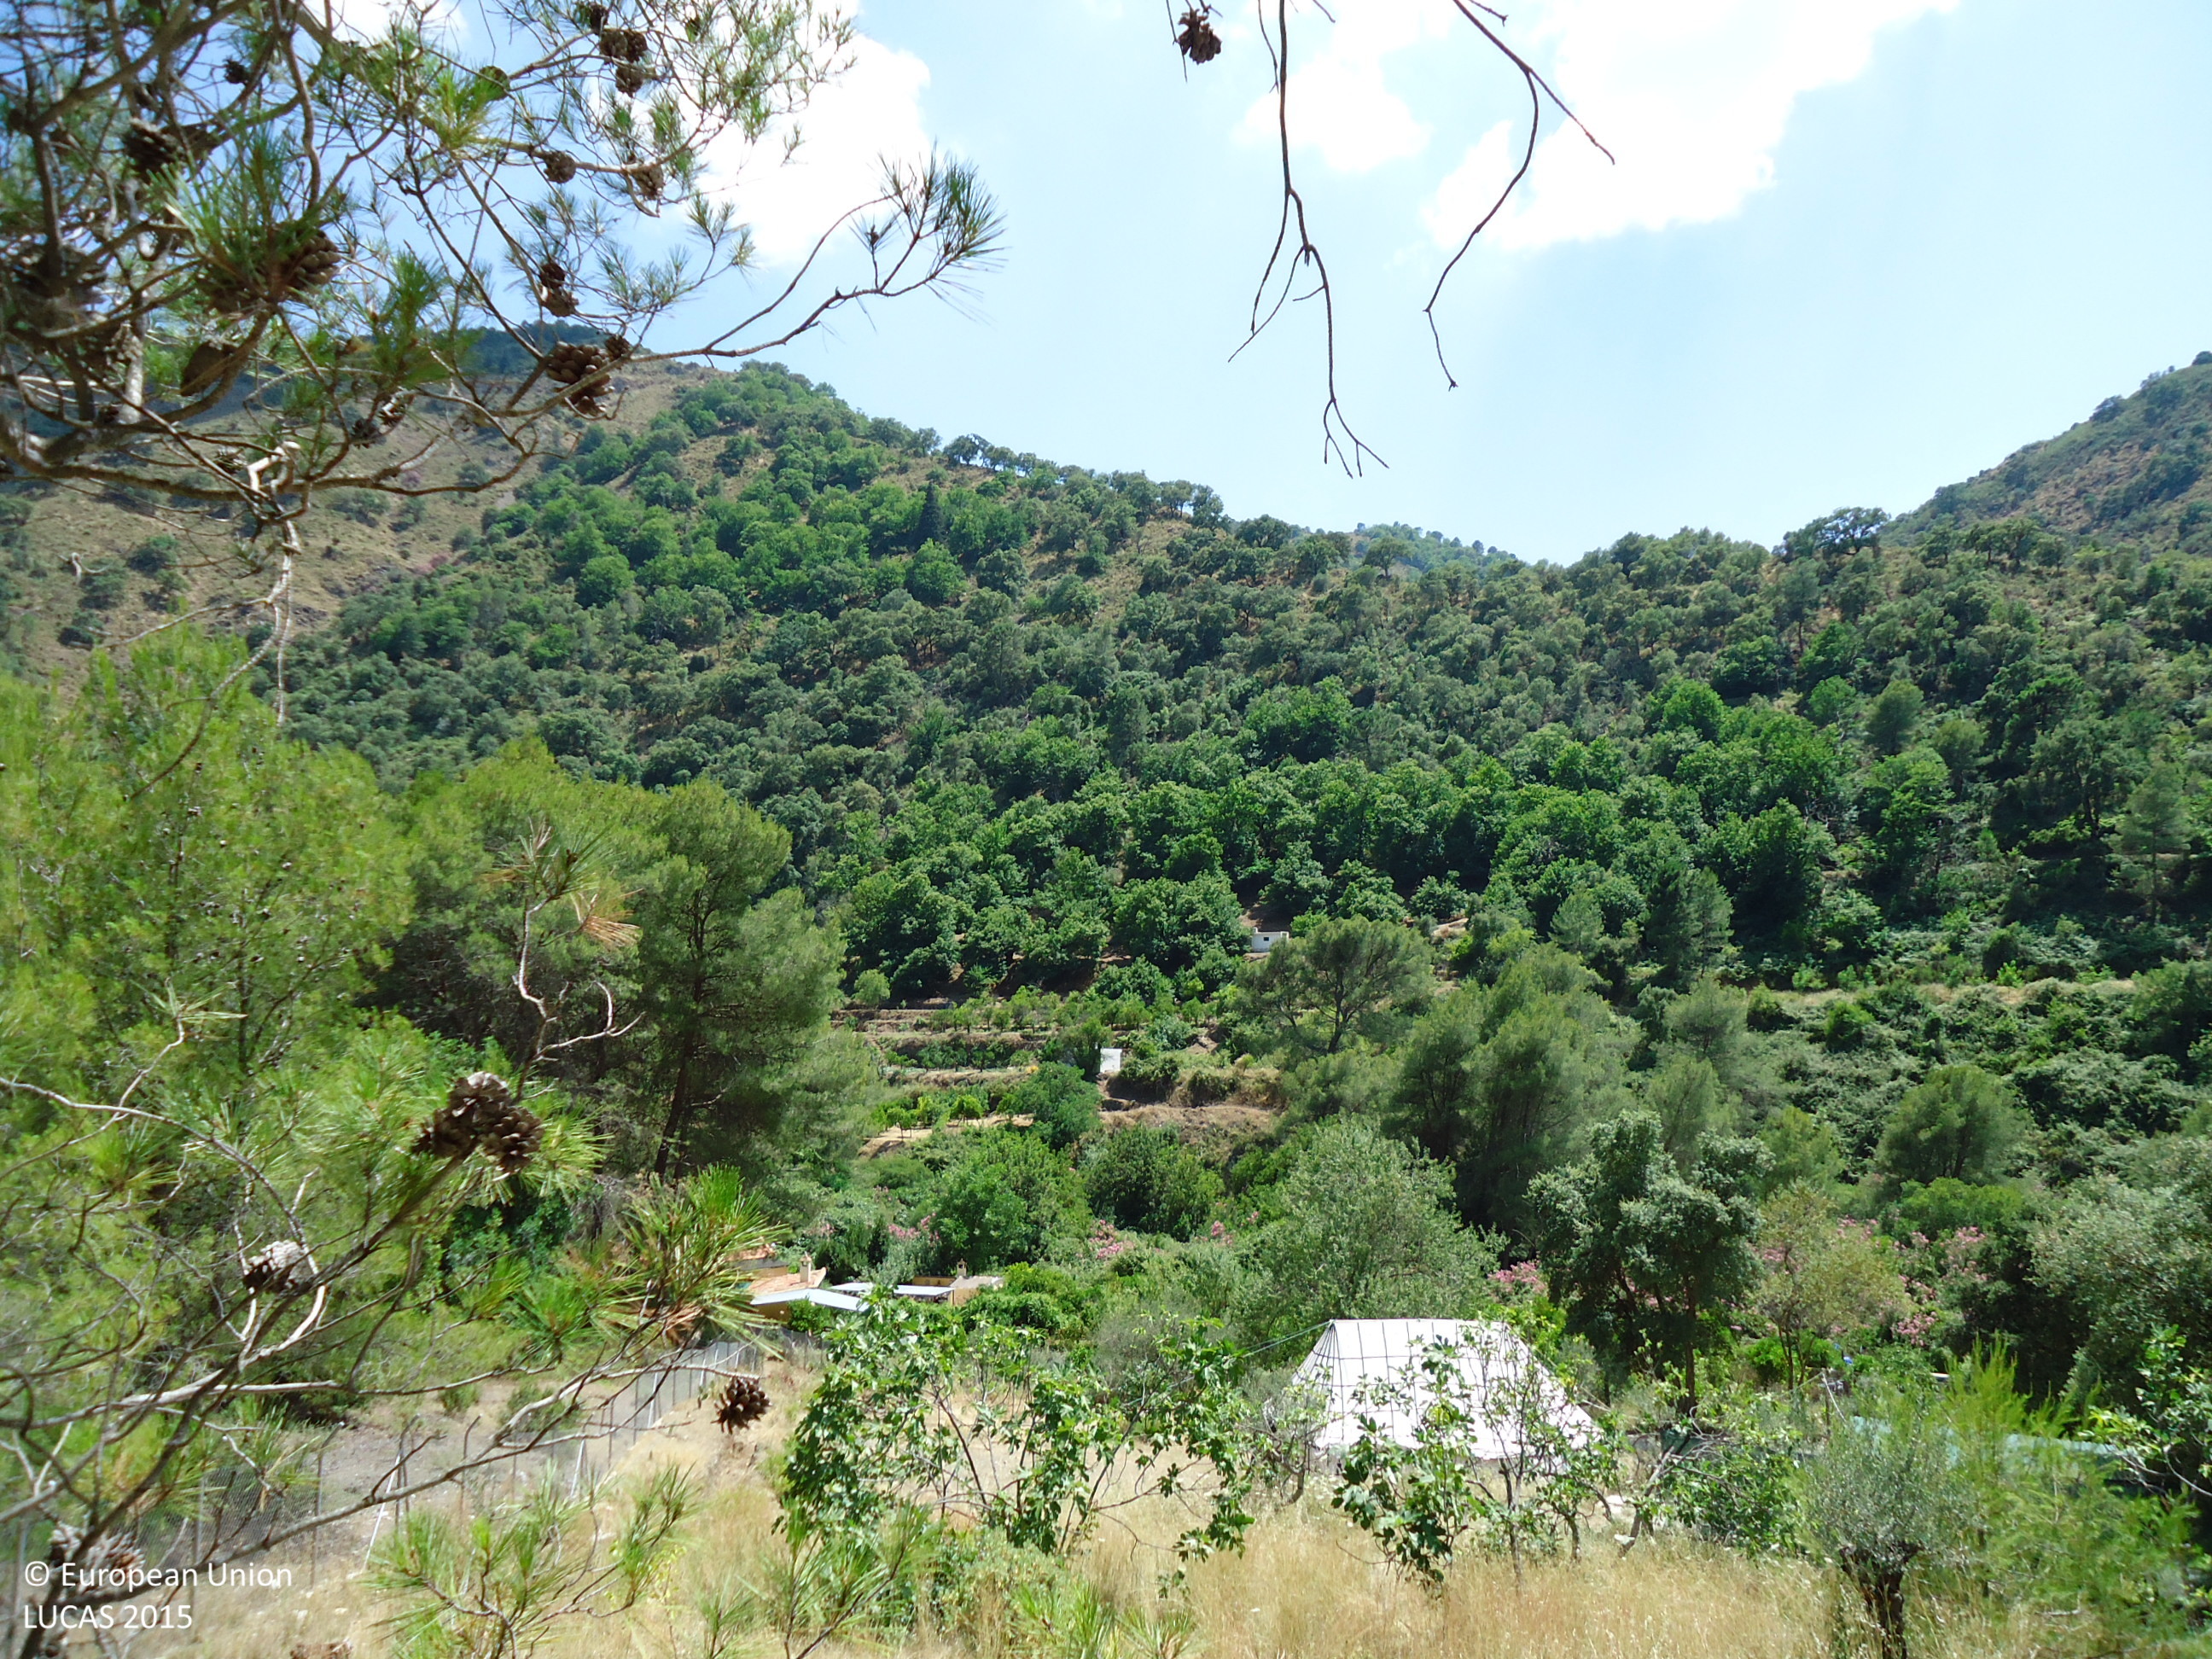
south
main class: Cropland
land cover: Olive groves
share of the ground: 10 - 25 %
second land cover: Spontaneously vegetated surfaces
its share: > 75 %
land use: Agriculture (excluding fallow land and kitchen gardens)
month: June
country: ES
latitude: 36.6896
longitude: -4.9362
